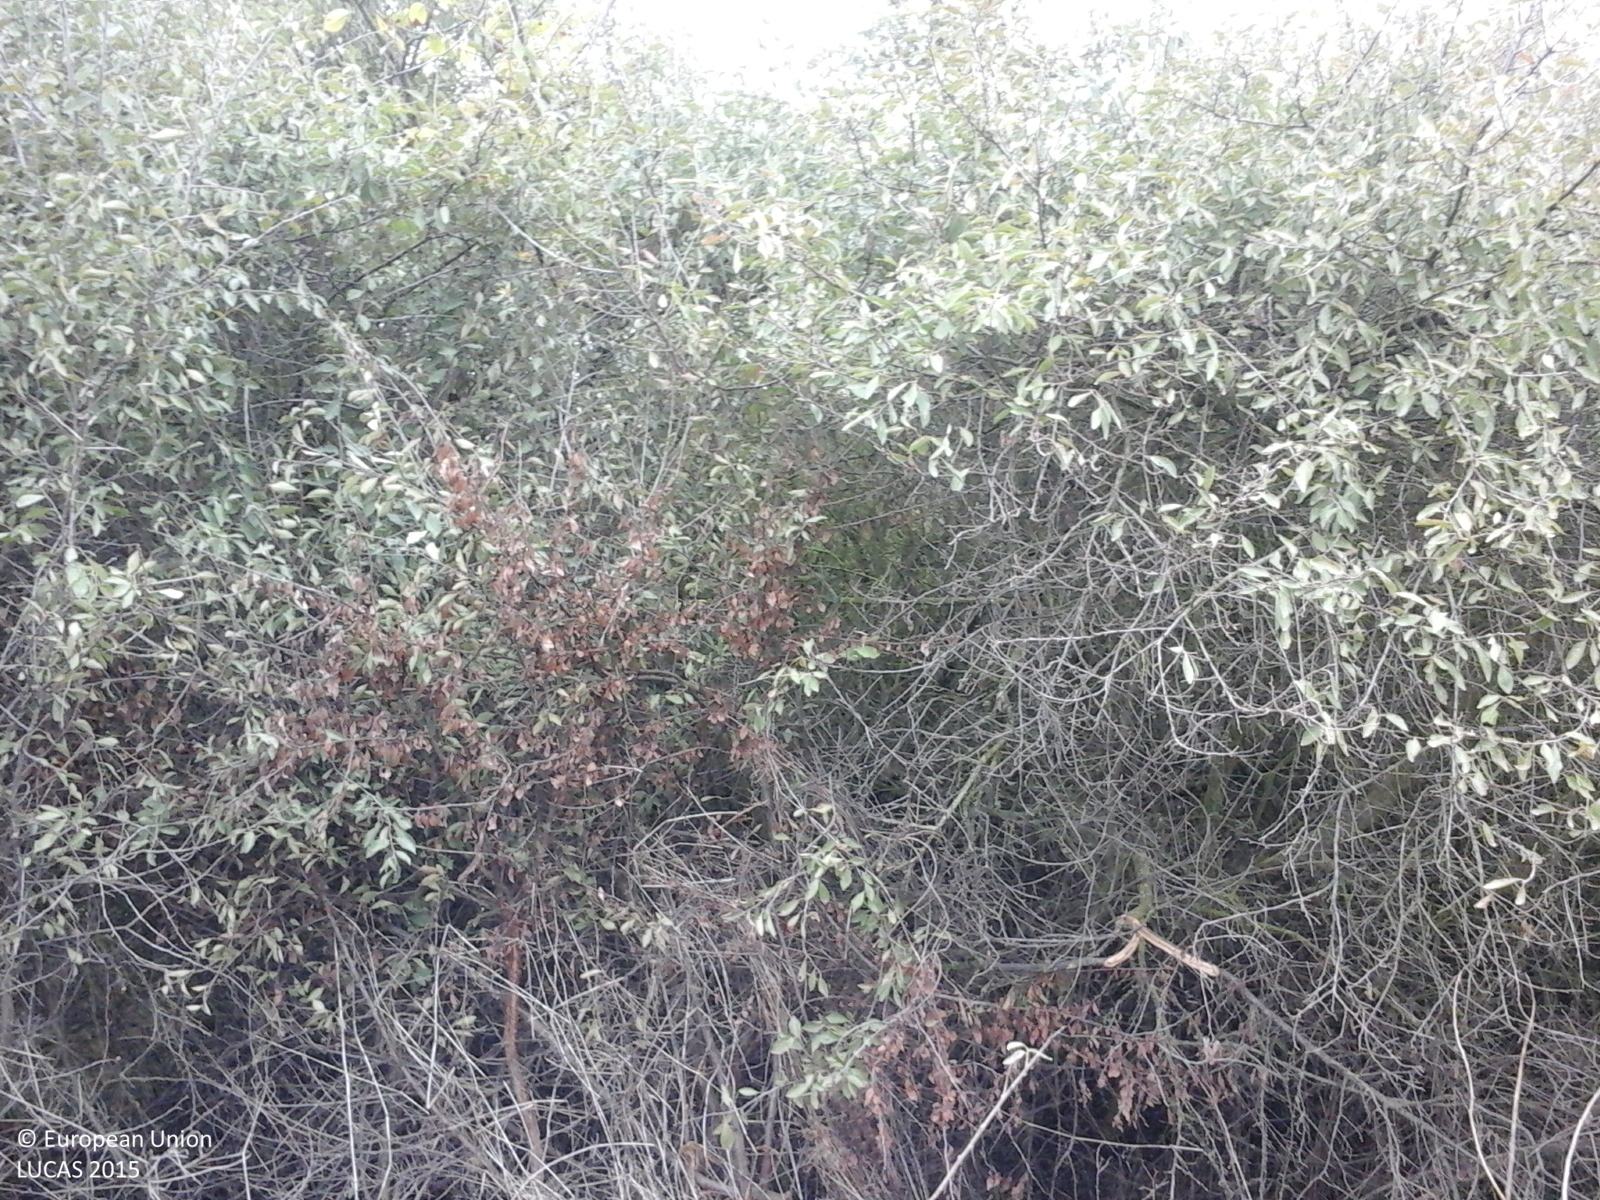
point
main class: Shrubland
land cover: Shrubland with sparse tree cover
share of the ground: > 75 %
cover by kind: shrubs 95 %, broadleaved forest trees 5 %
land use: Semi-natural and natural areas not in use
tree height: < 5 m
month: October
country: RO
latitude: 45.9110
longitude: 23.3528
